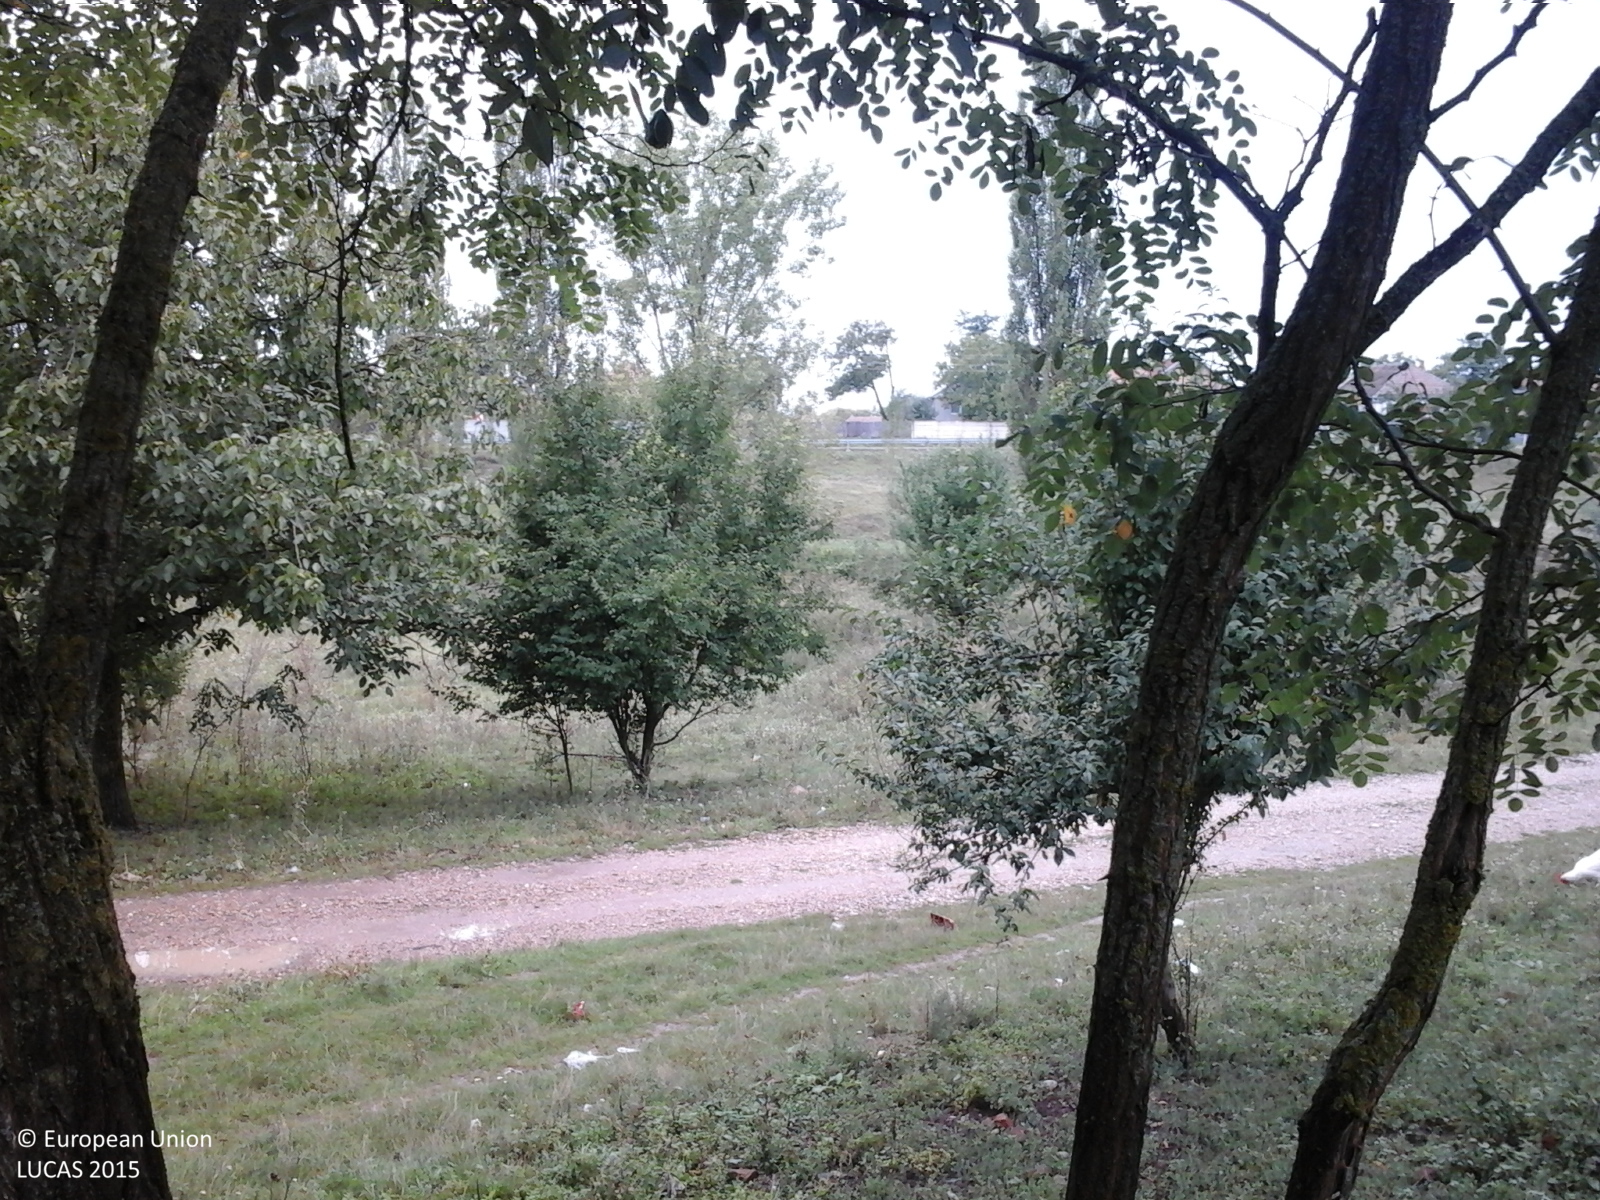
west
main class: Woodland
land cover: Broadleaved woodland
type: exotic forest
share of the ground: > 75 %
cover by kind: broadleaved forest trees 100 %
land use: Forestry
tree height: > 5 m
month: September
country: RO
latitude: 46.8411
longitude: 21.8053
